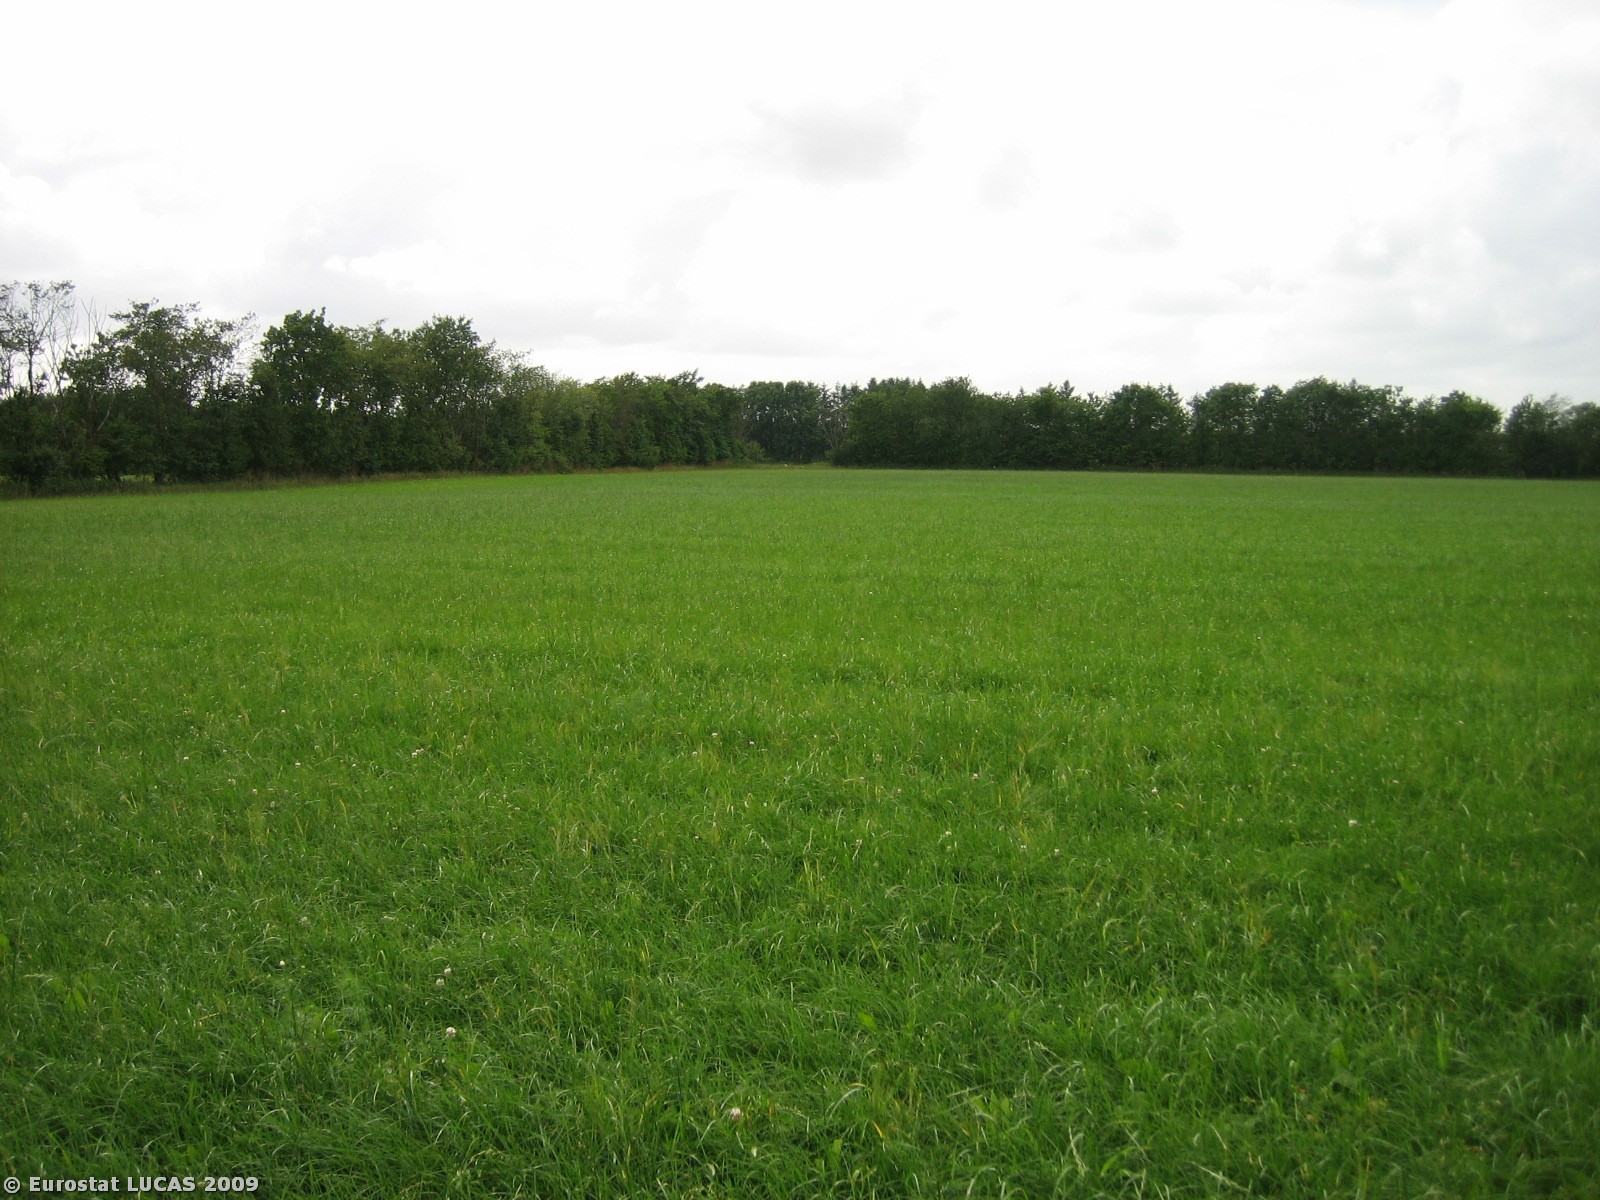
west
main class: Cropland
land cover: Temporary grasslands
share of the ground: > 75 %
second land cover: Rye
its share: < 10 %
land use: Agriculture (excluding fallow land and kitchen gardens)
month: July
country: DK
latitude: 55.6962
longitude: 8.7443
